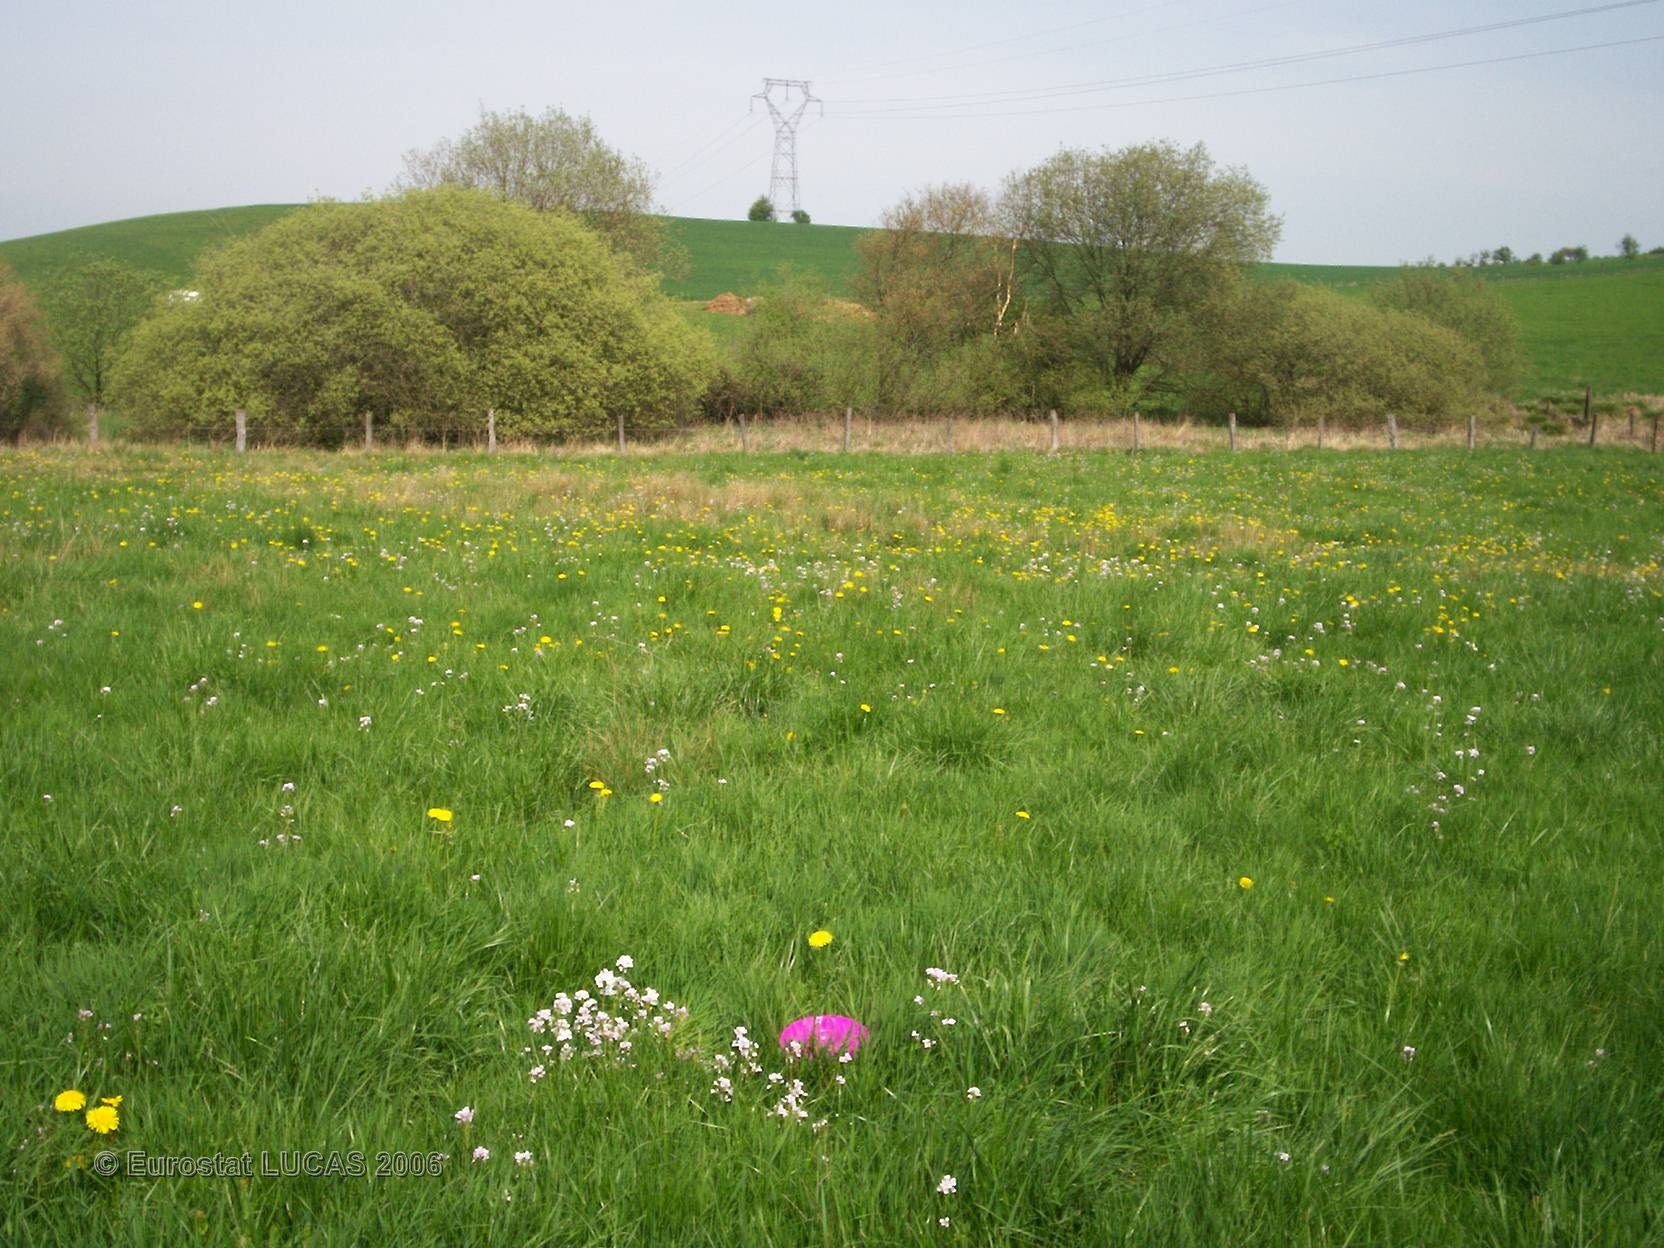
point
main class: Grassland
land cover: Grassland without tree/shrub cover
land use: Agriculture (excluding fallow land and kitchen gardens)
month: May
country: FR
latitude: 49.0650
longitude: 7.0030
